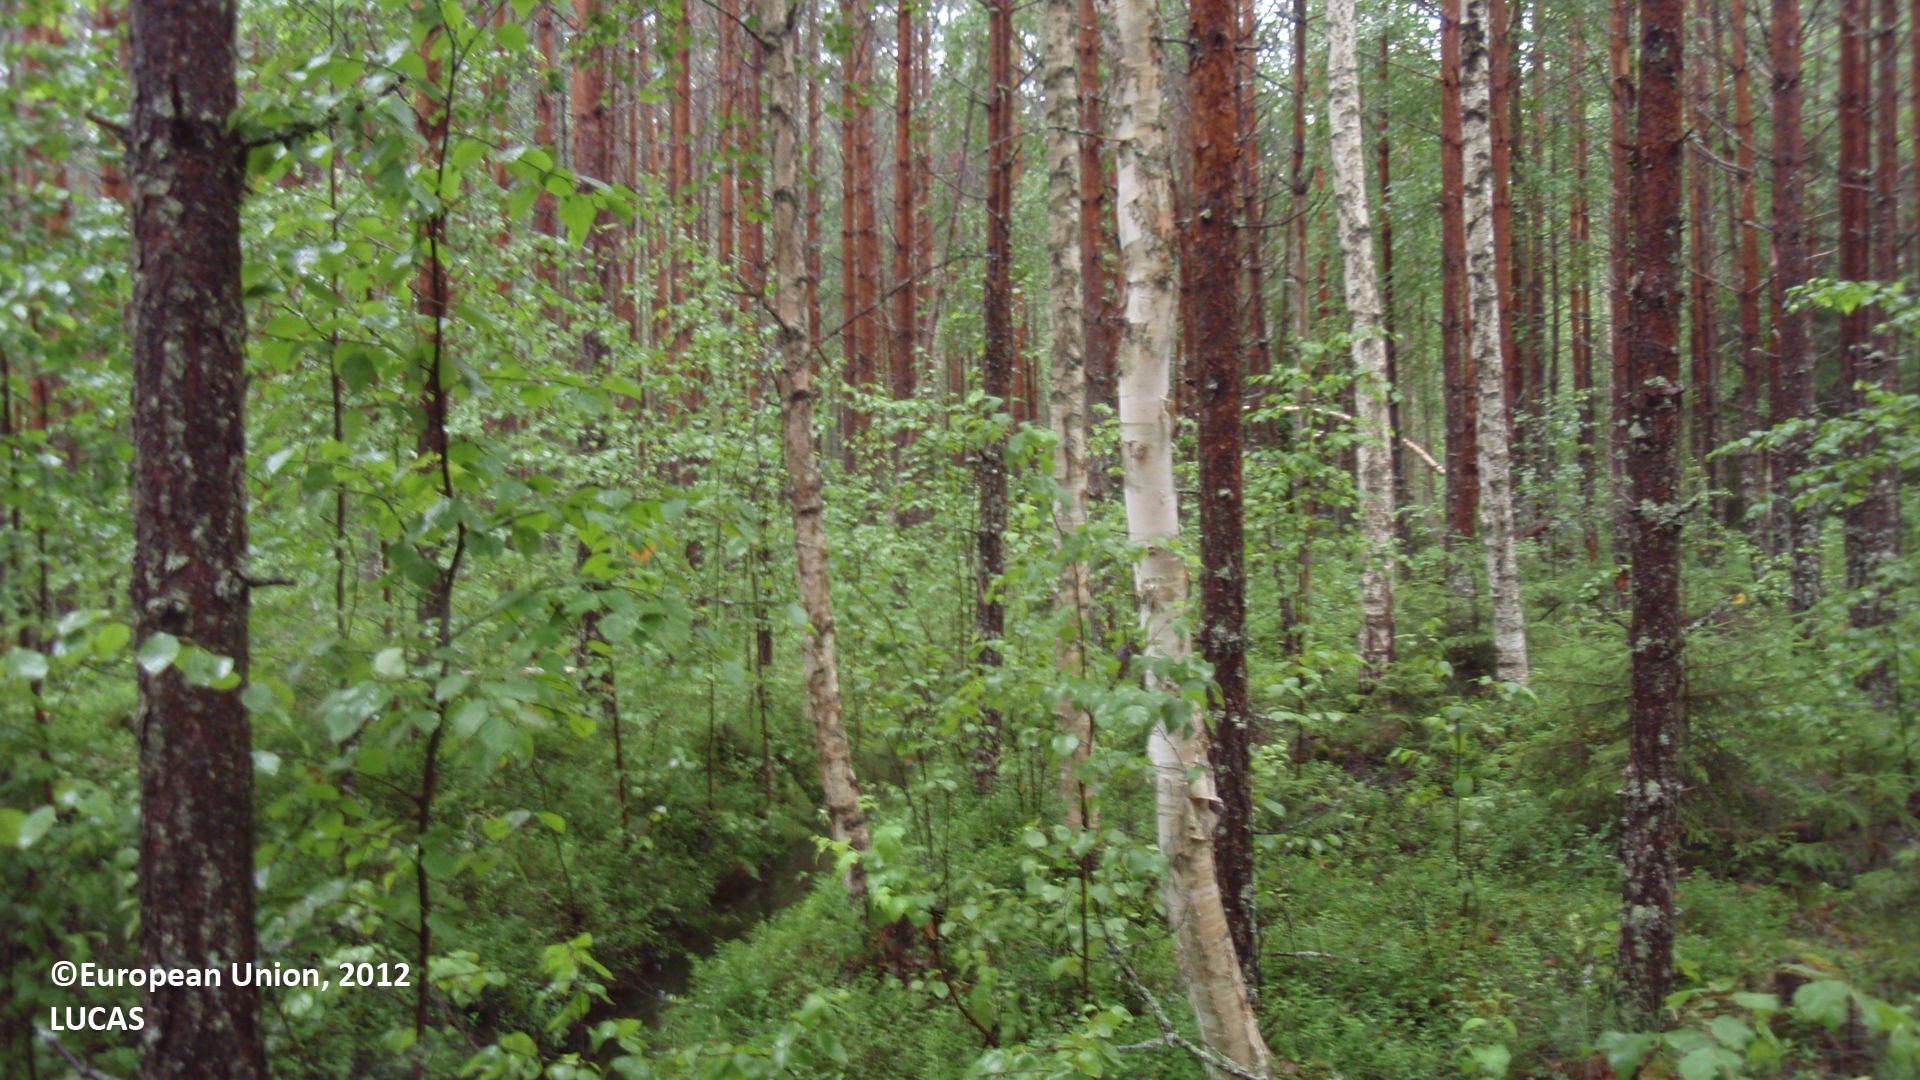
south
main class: Woodland
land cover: Pine dominated mixed woodland
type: boreal forest
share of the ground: > 75 %
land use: Forestry
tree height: > 5 m
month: July
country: FI
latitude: 61.4286
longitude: 27.0138
